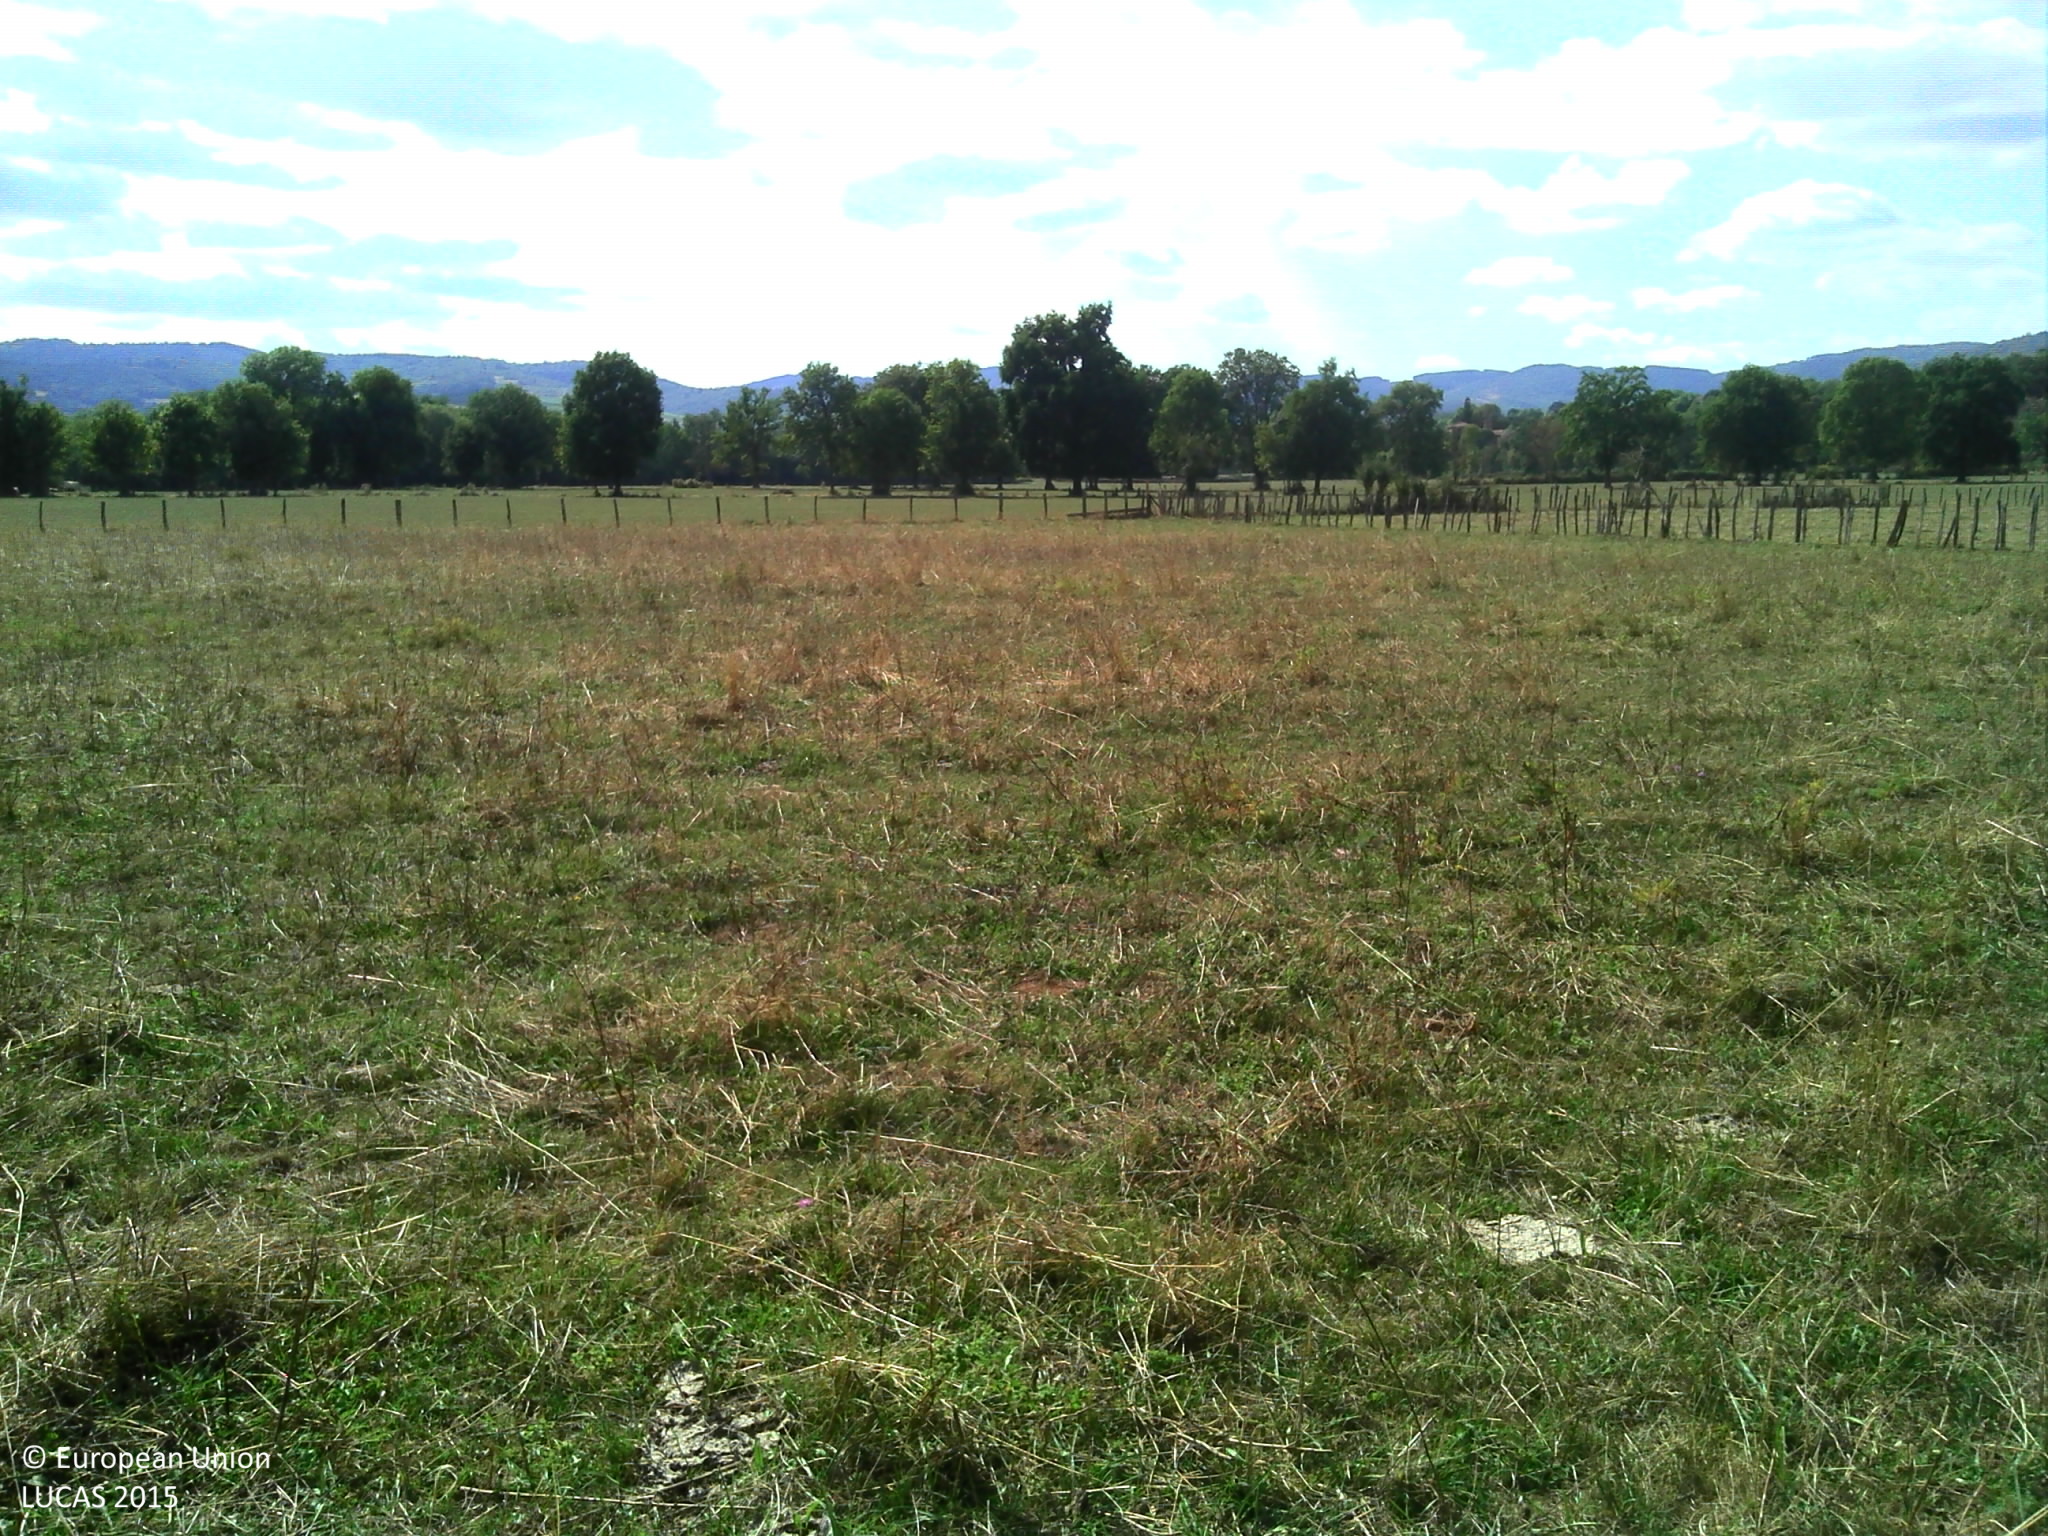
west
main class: Grassland
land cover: Grassland without tree/shrub cover
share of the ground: > 75 %
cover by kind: herbaceous plants 100 %
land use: Agriculture (excluding fallow land and kitchen gardens)
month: August
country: FR
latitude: 46.0556
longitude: 4.6644
